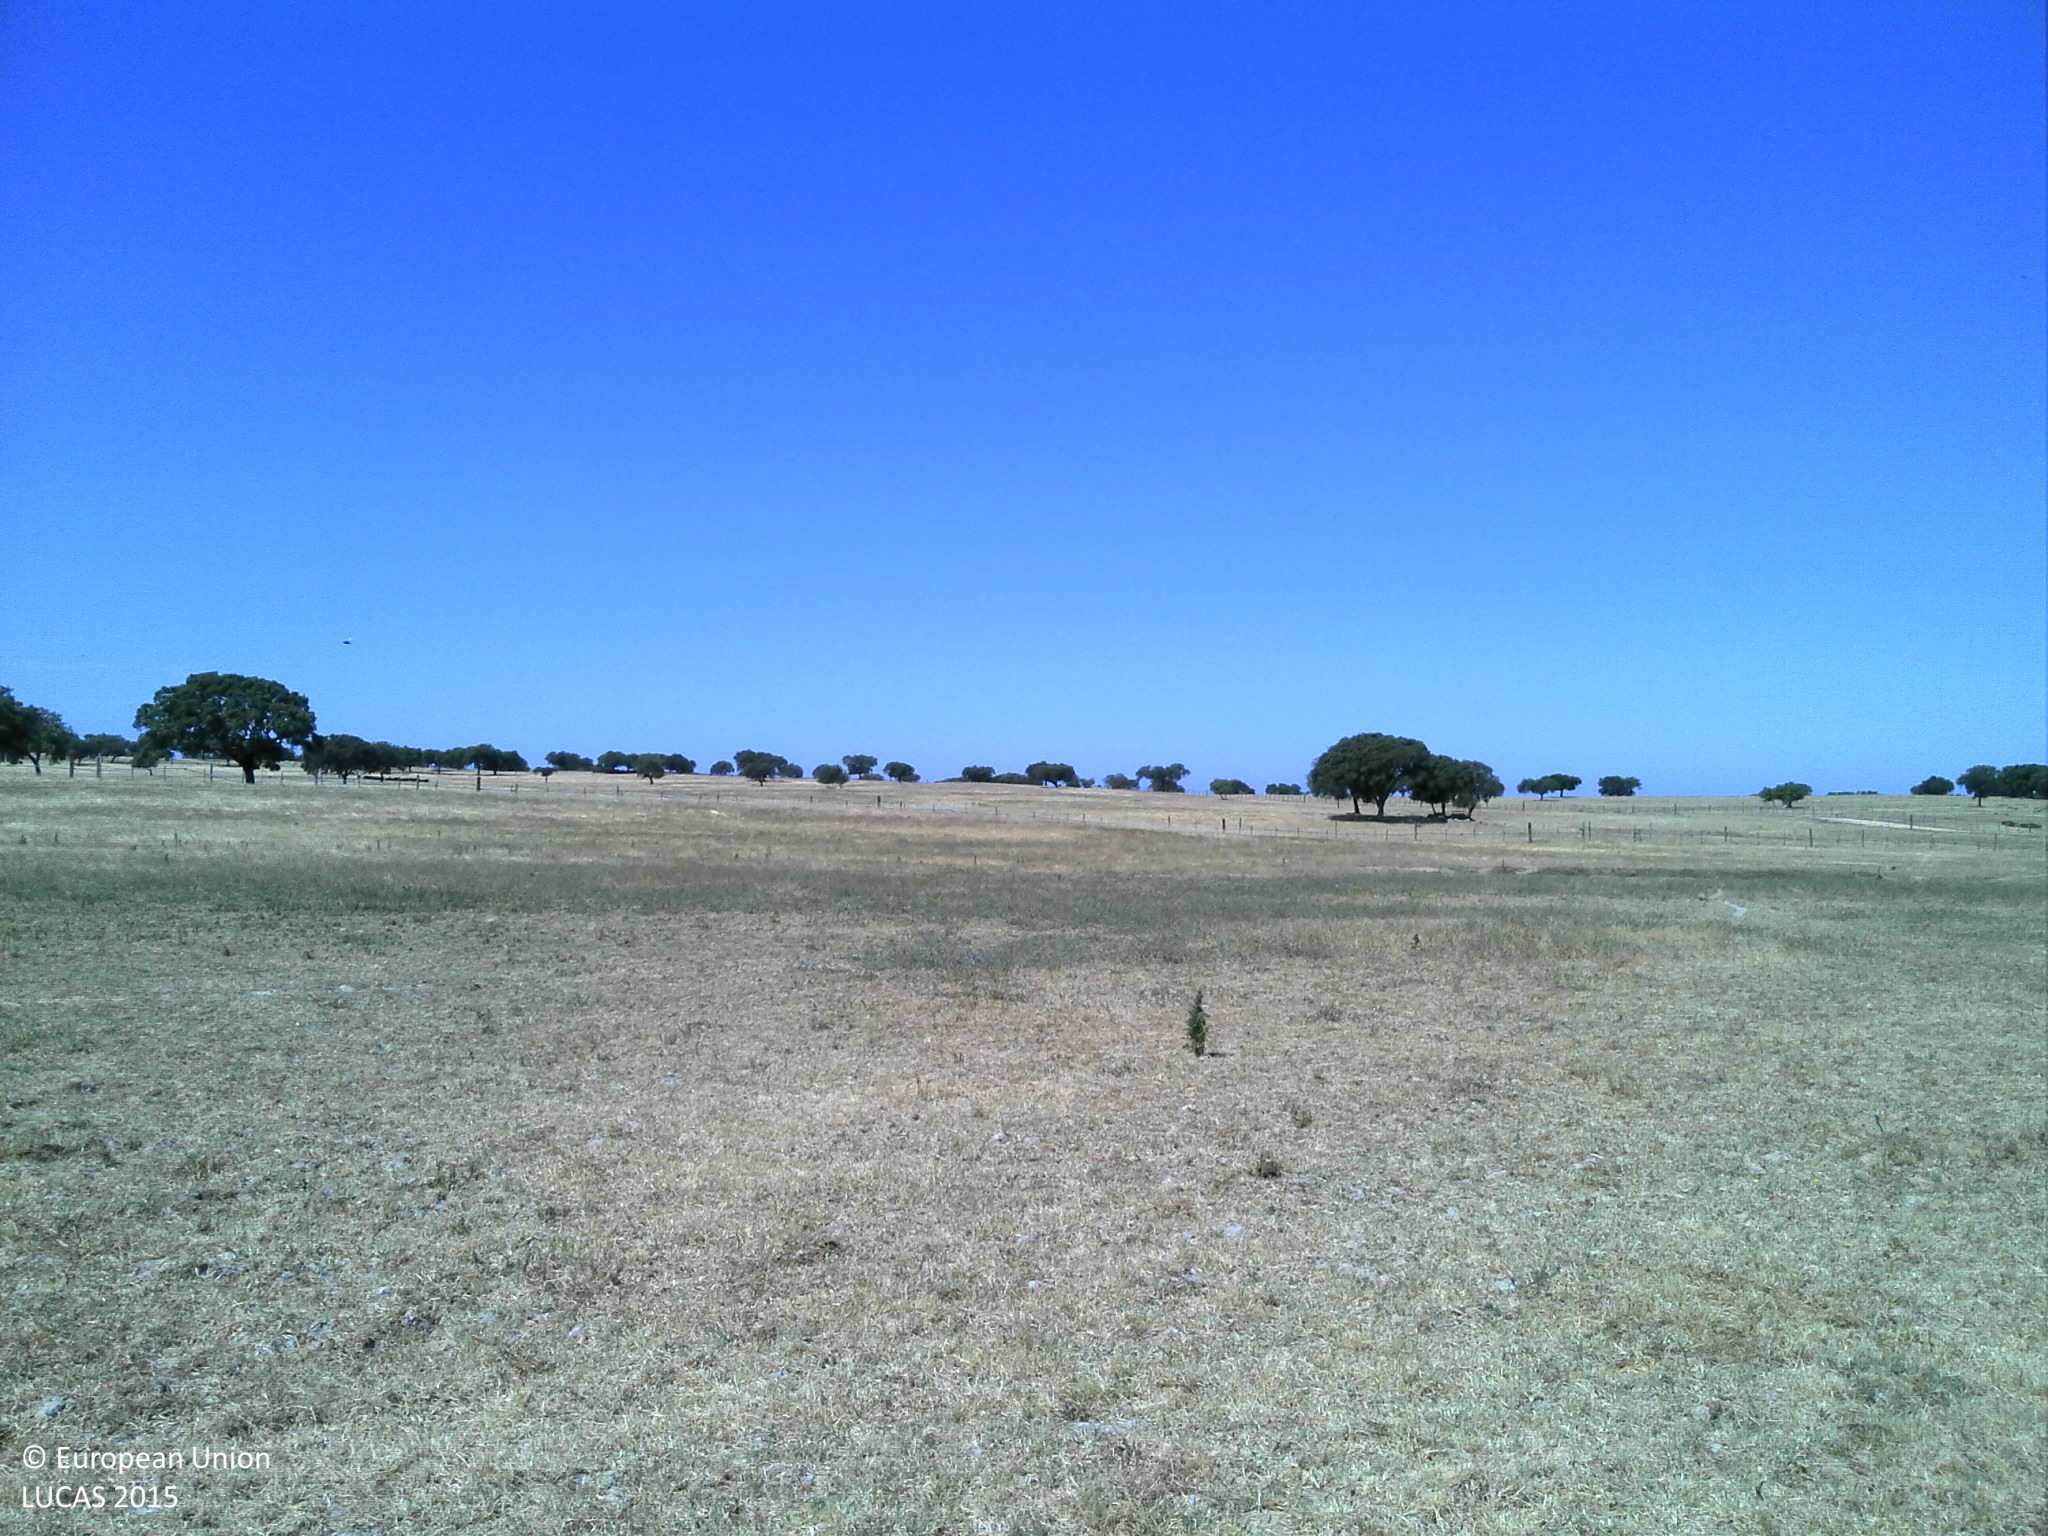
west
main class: Grassland
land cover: Spontaneously vegetated surfaces
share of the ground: > 75 %
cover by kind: herbaceous plants 75 %, unconsolidated bare surface 25 %
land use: Agriculture (excluding fallow land and kitchen gardens)
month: June
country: PT
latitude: 38.7486
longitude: -8.2187
